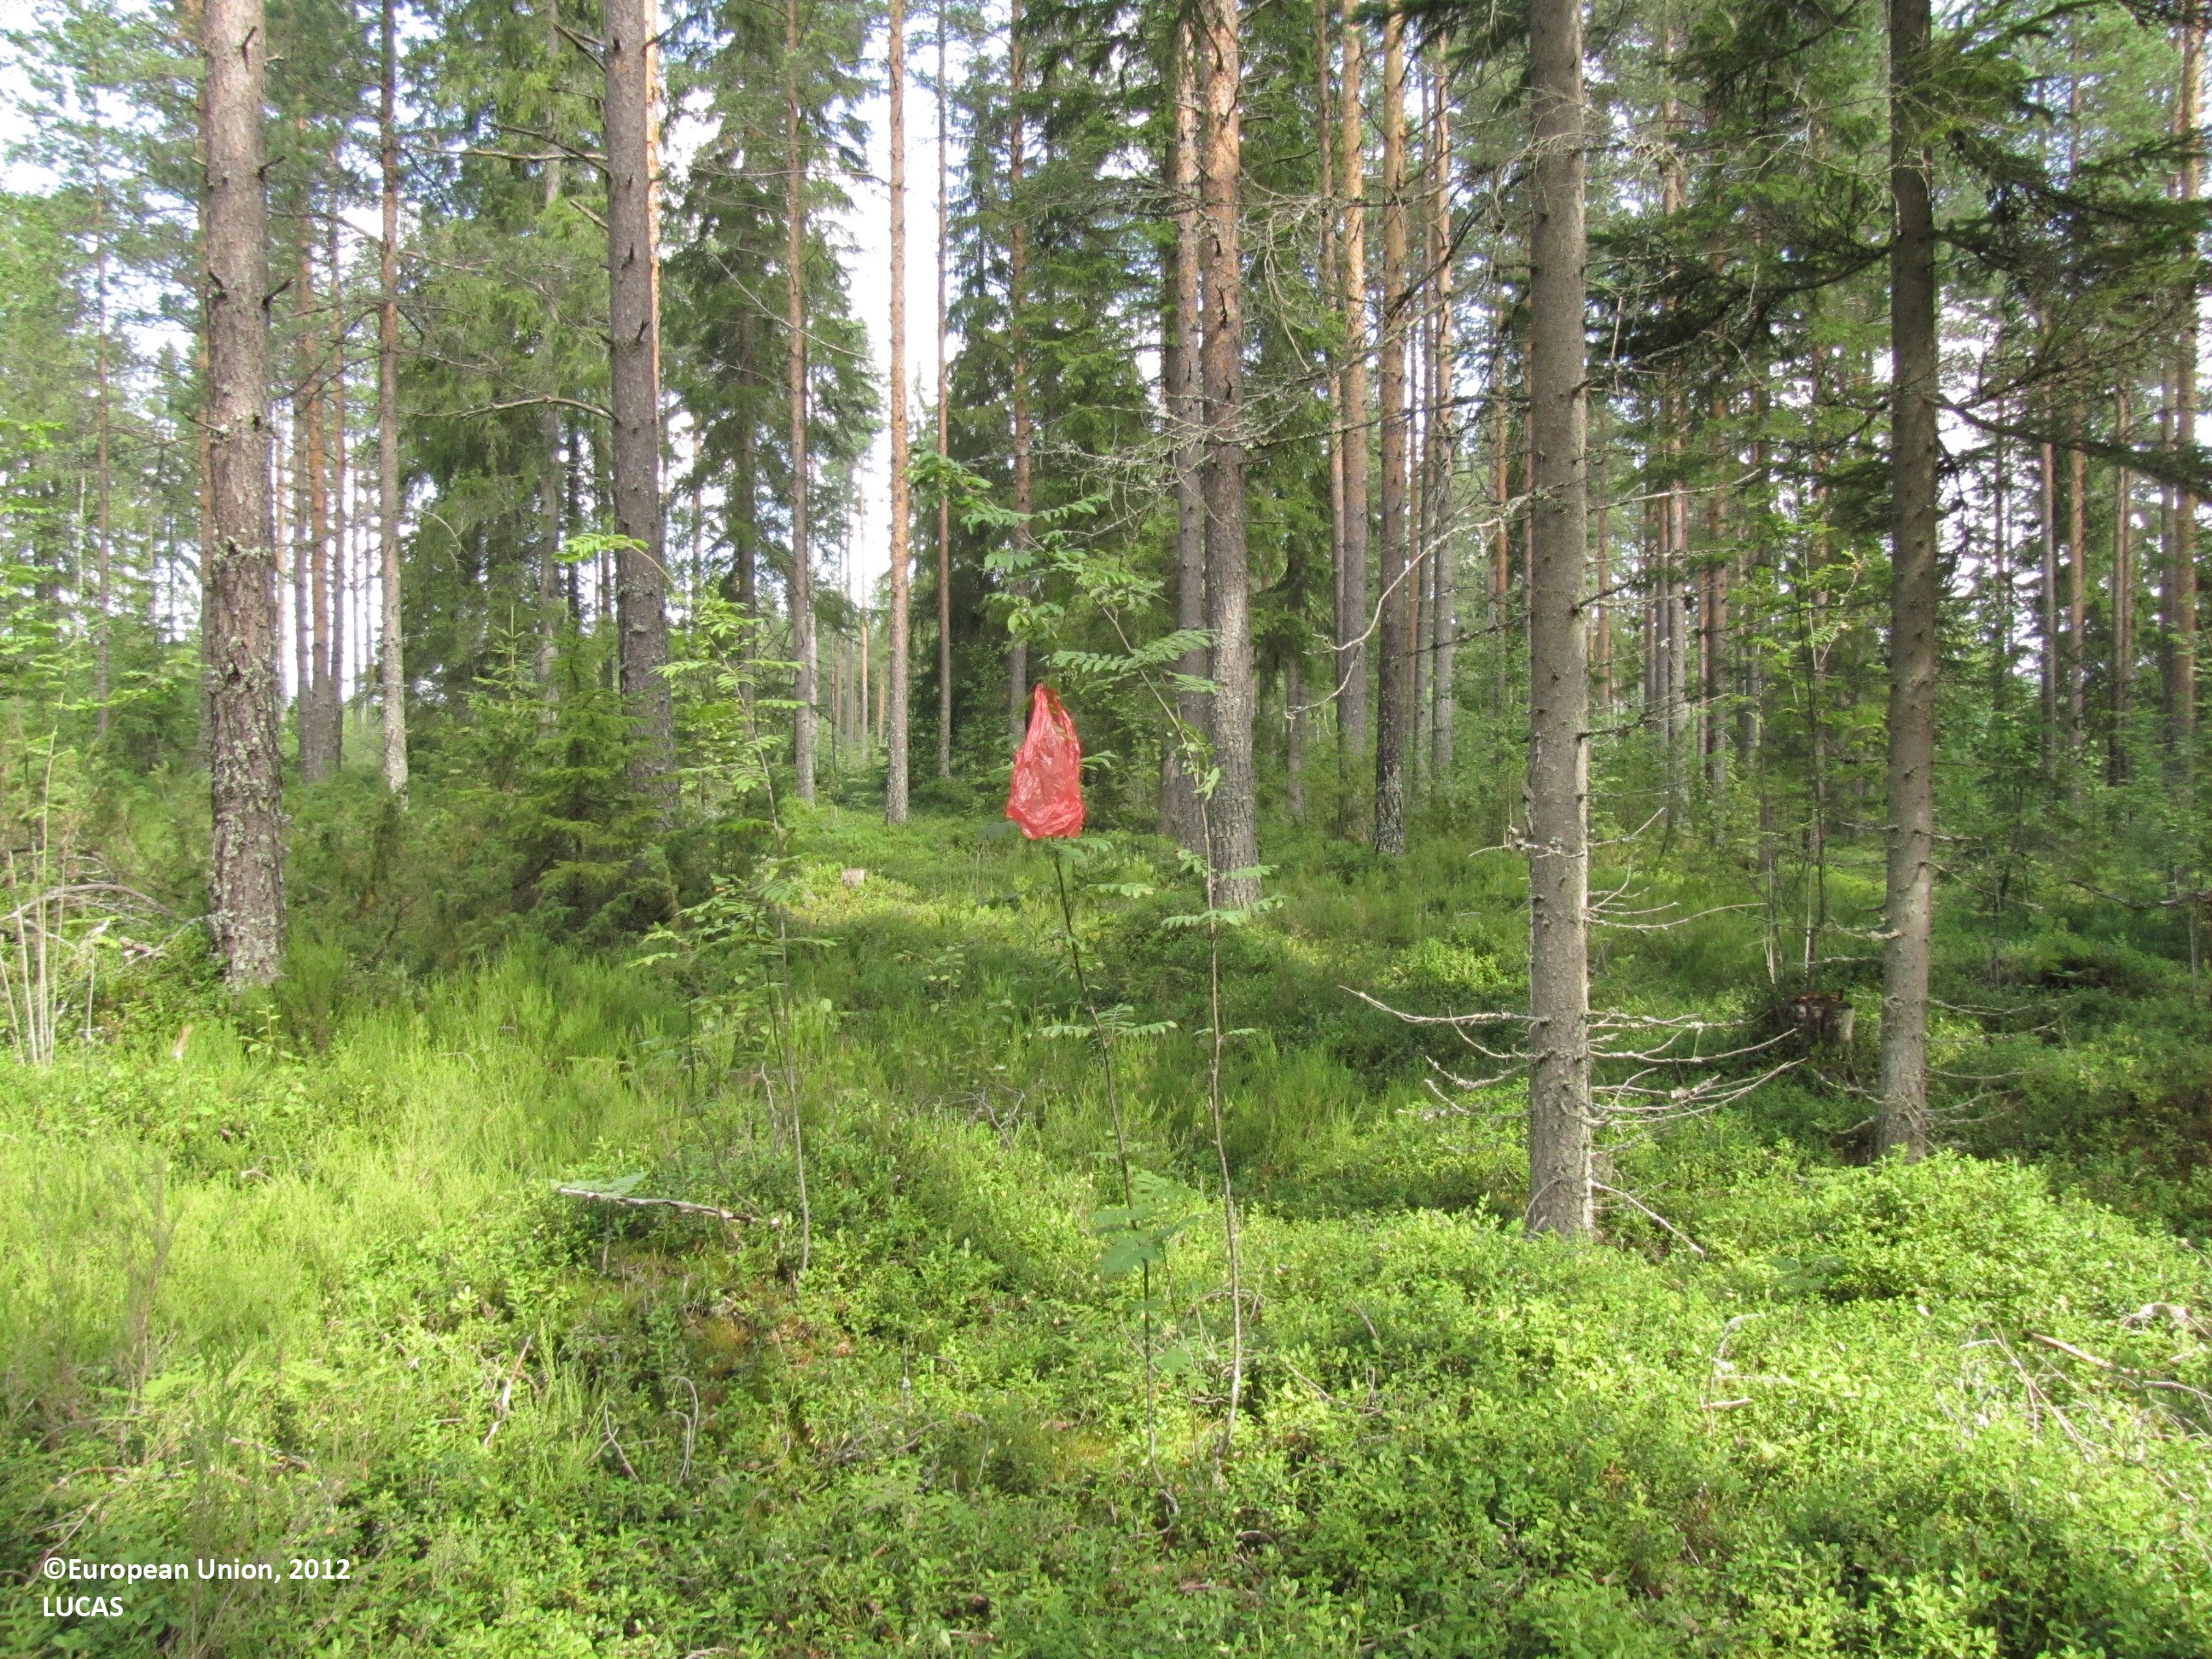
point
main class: Woodland
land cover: Other coniferous woodland
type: boreal forest
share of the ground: 50 - 75 %
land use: Forestry
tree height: > 5 m
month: July
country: FI
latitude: 62.2112
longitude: 23.2006
